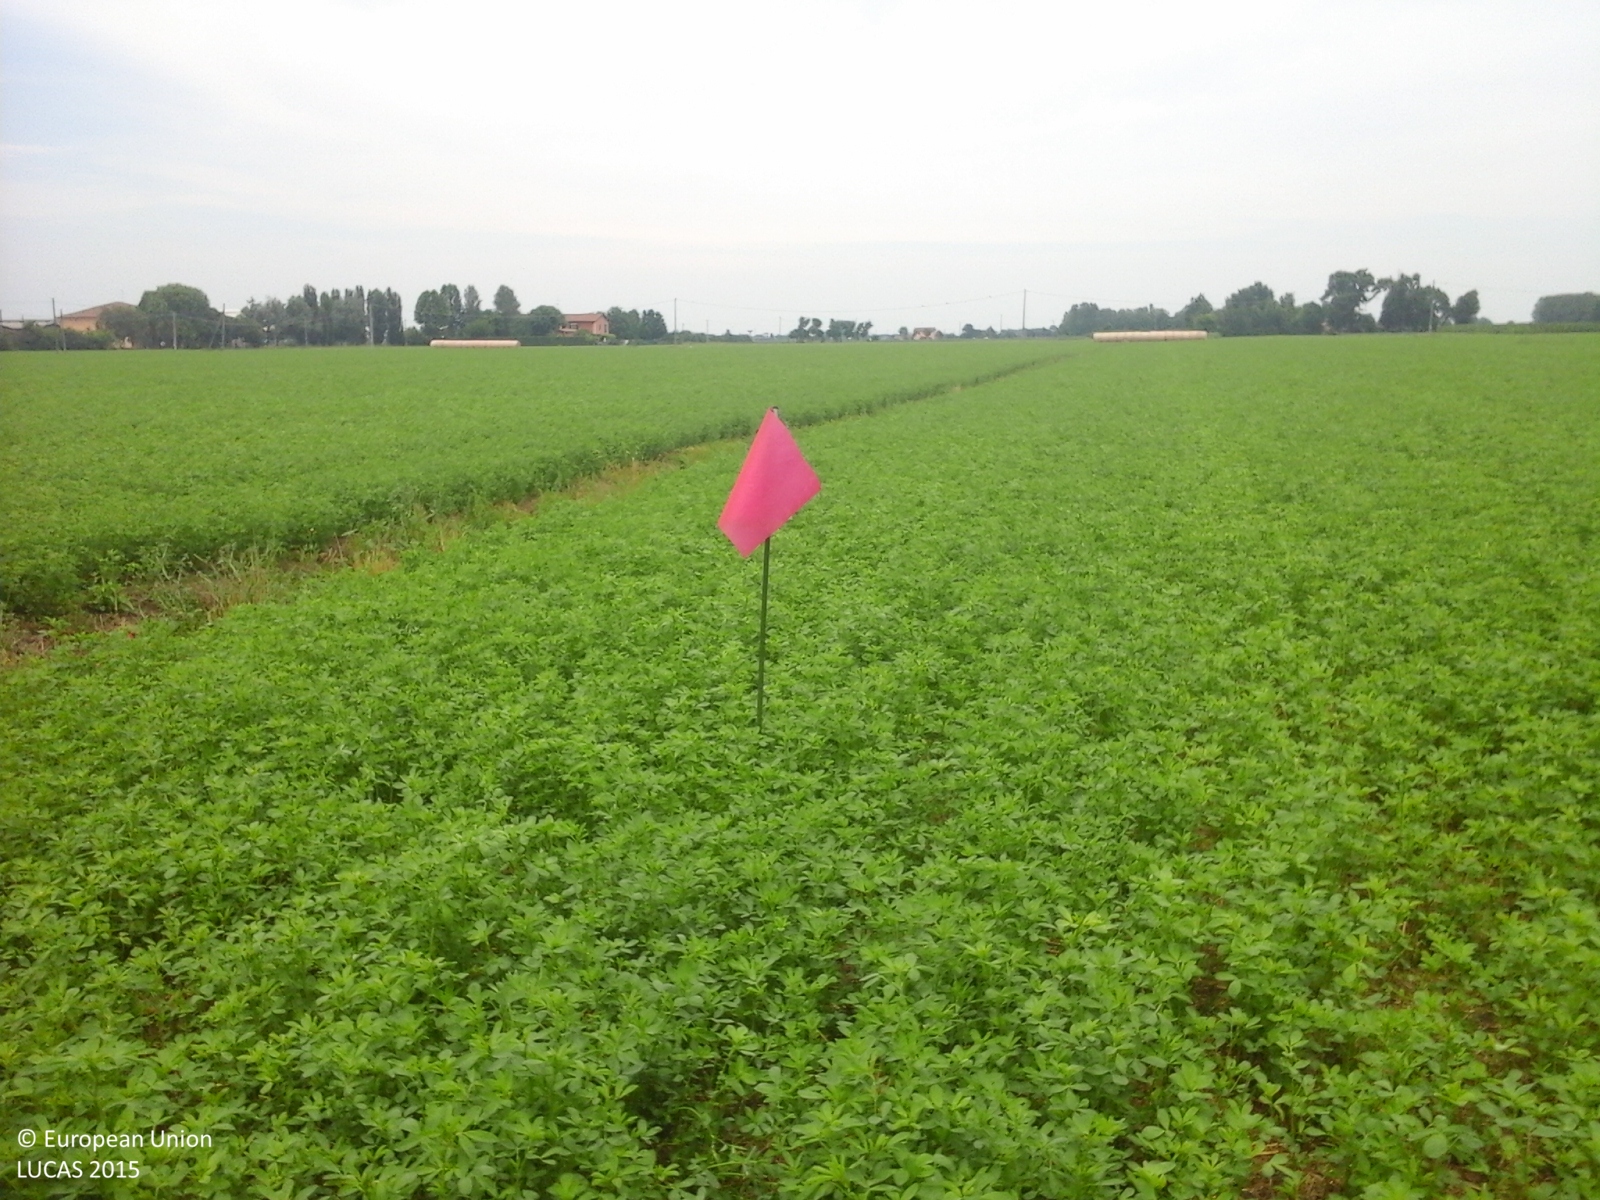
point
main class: Cropland
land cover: Lucerne
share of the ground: > 75 %
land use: Agriculture (excluding fallow land and kitchen gardens)
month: June
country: IT
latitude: 44.6151
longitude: 11.1192
